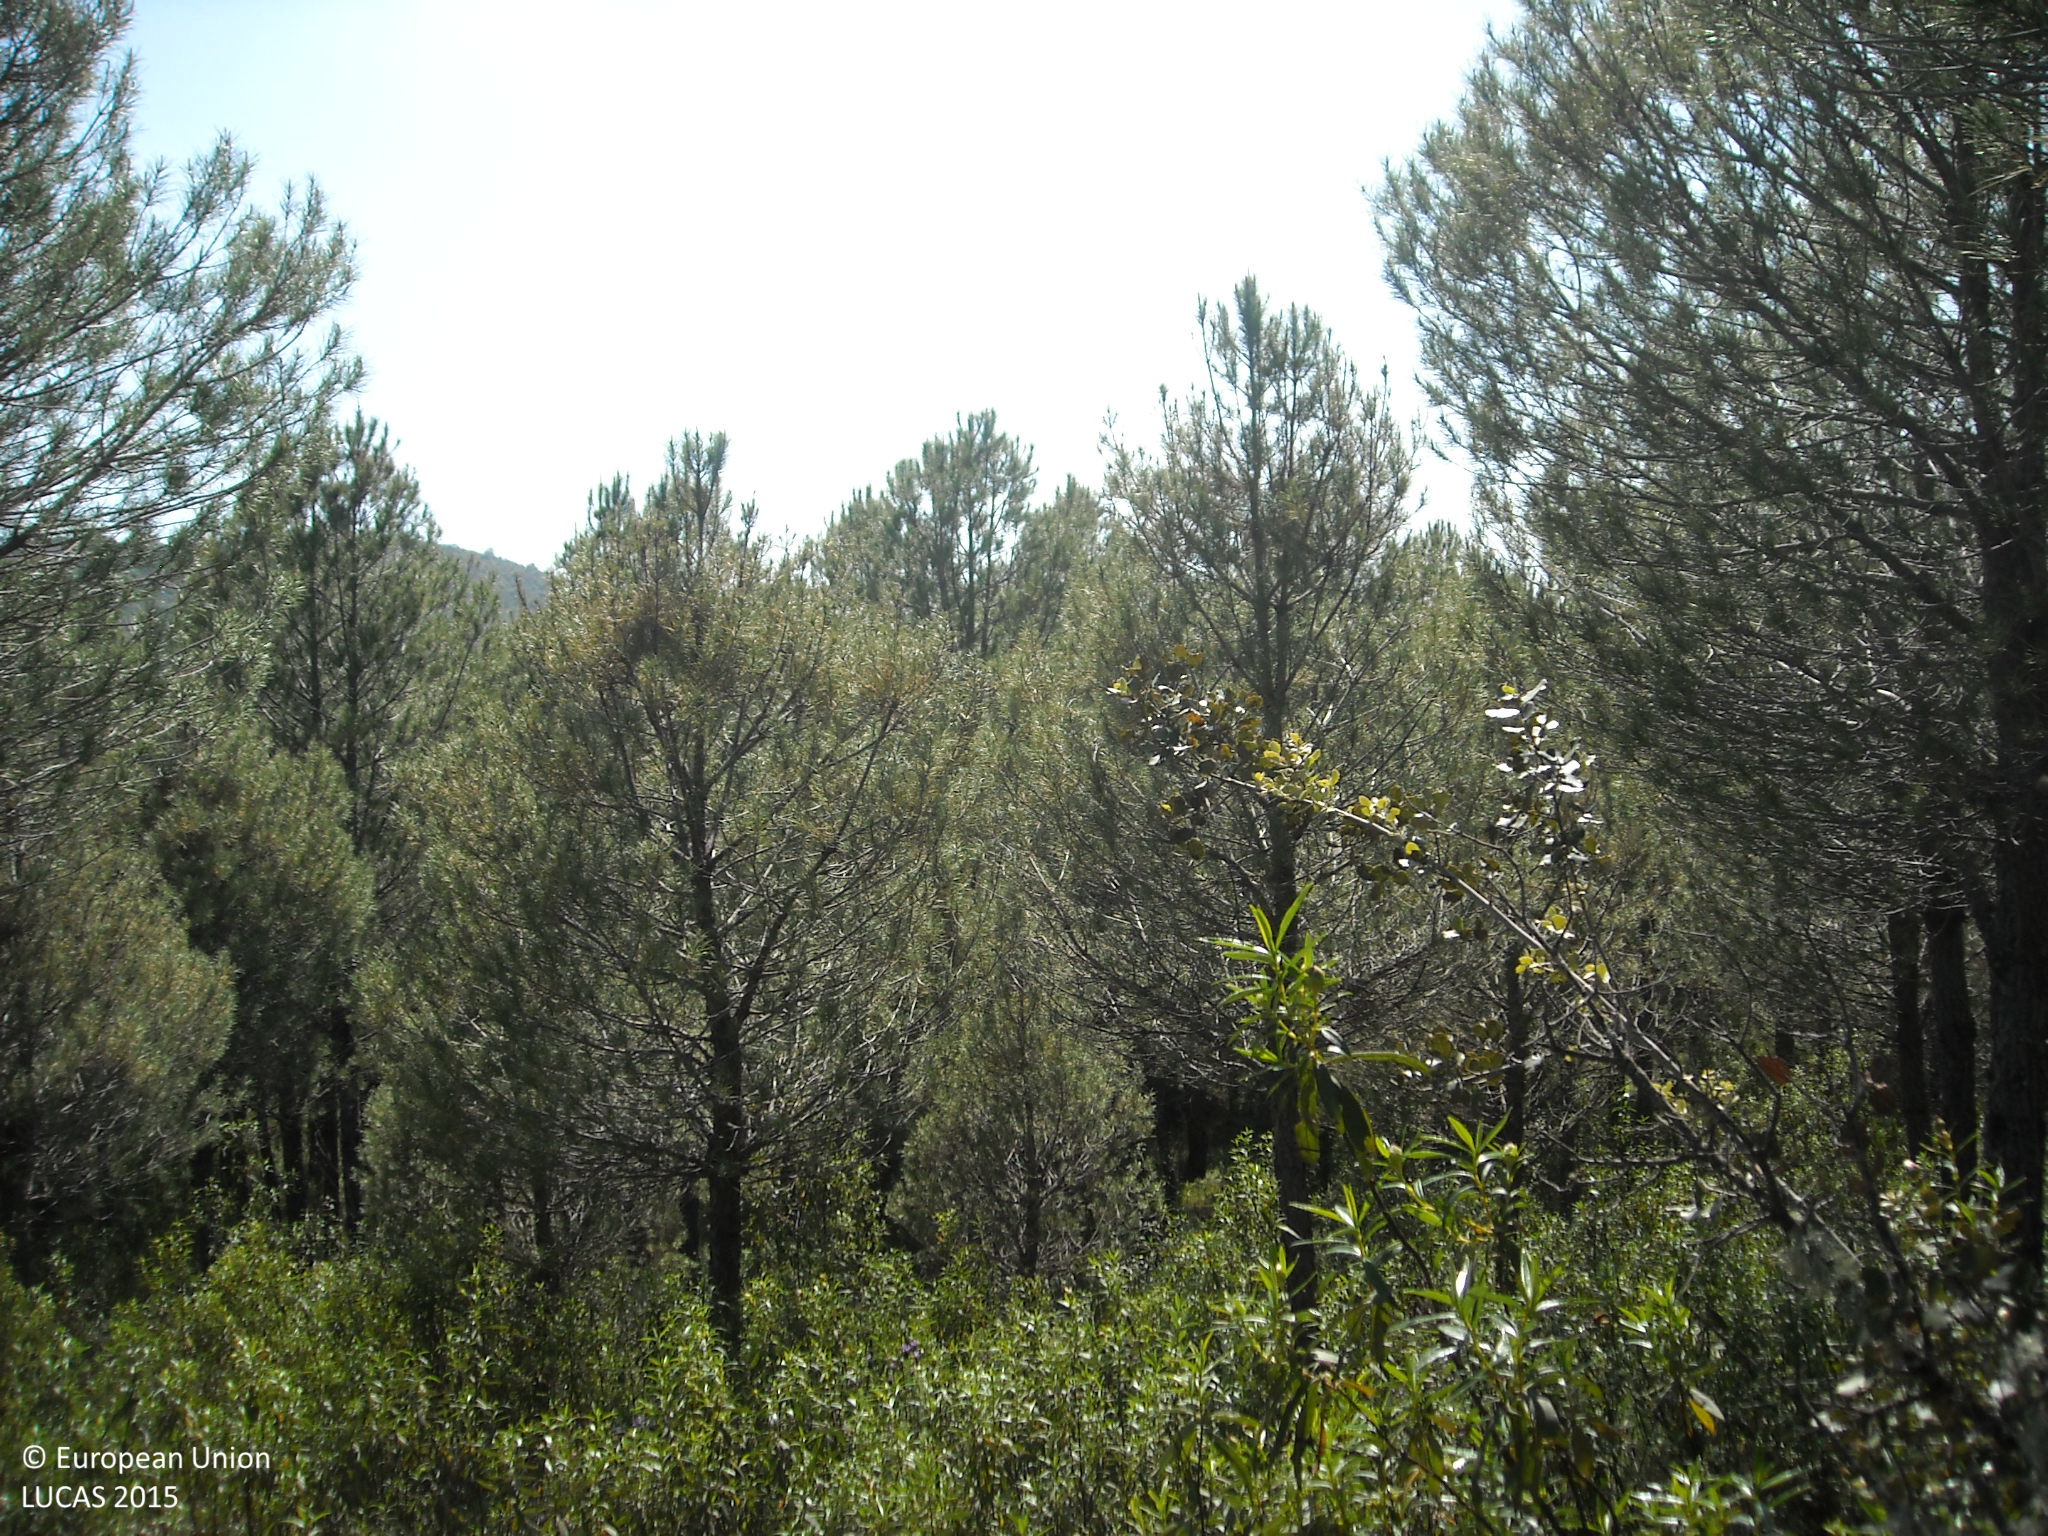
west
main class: Woodland
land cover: Pine dominated coniferous woodland
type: coniferous forest of the mediterranean region
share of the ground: 25 - 50 %
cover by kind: coniferous forest trees 40 %, shrubs 40 %, herbaceous plants 20 %
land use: Forestry
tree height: > 5 m
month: April
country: ES
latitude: 37.7027
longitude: -6.4730
